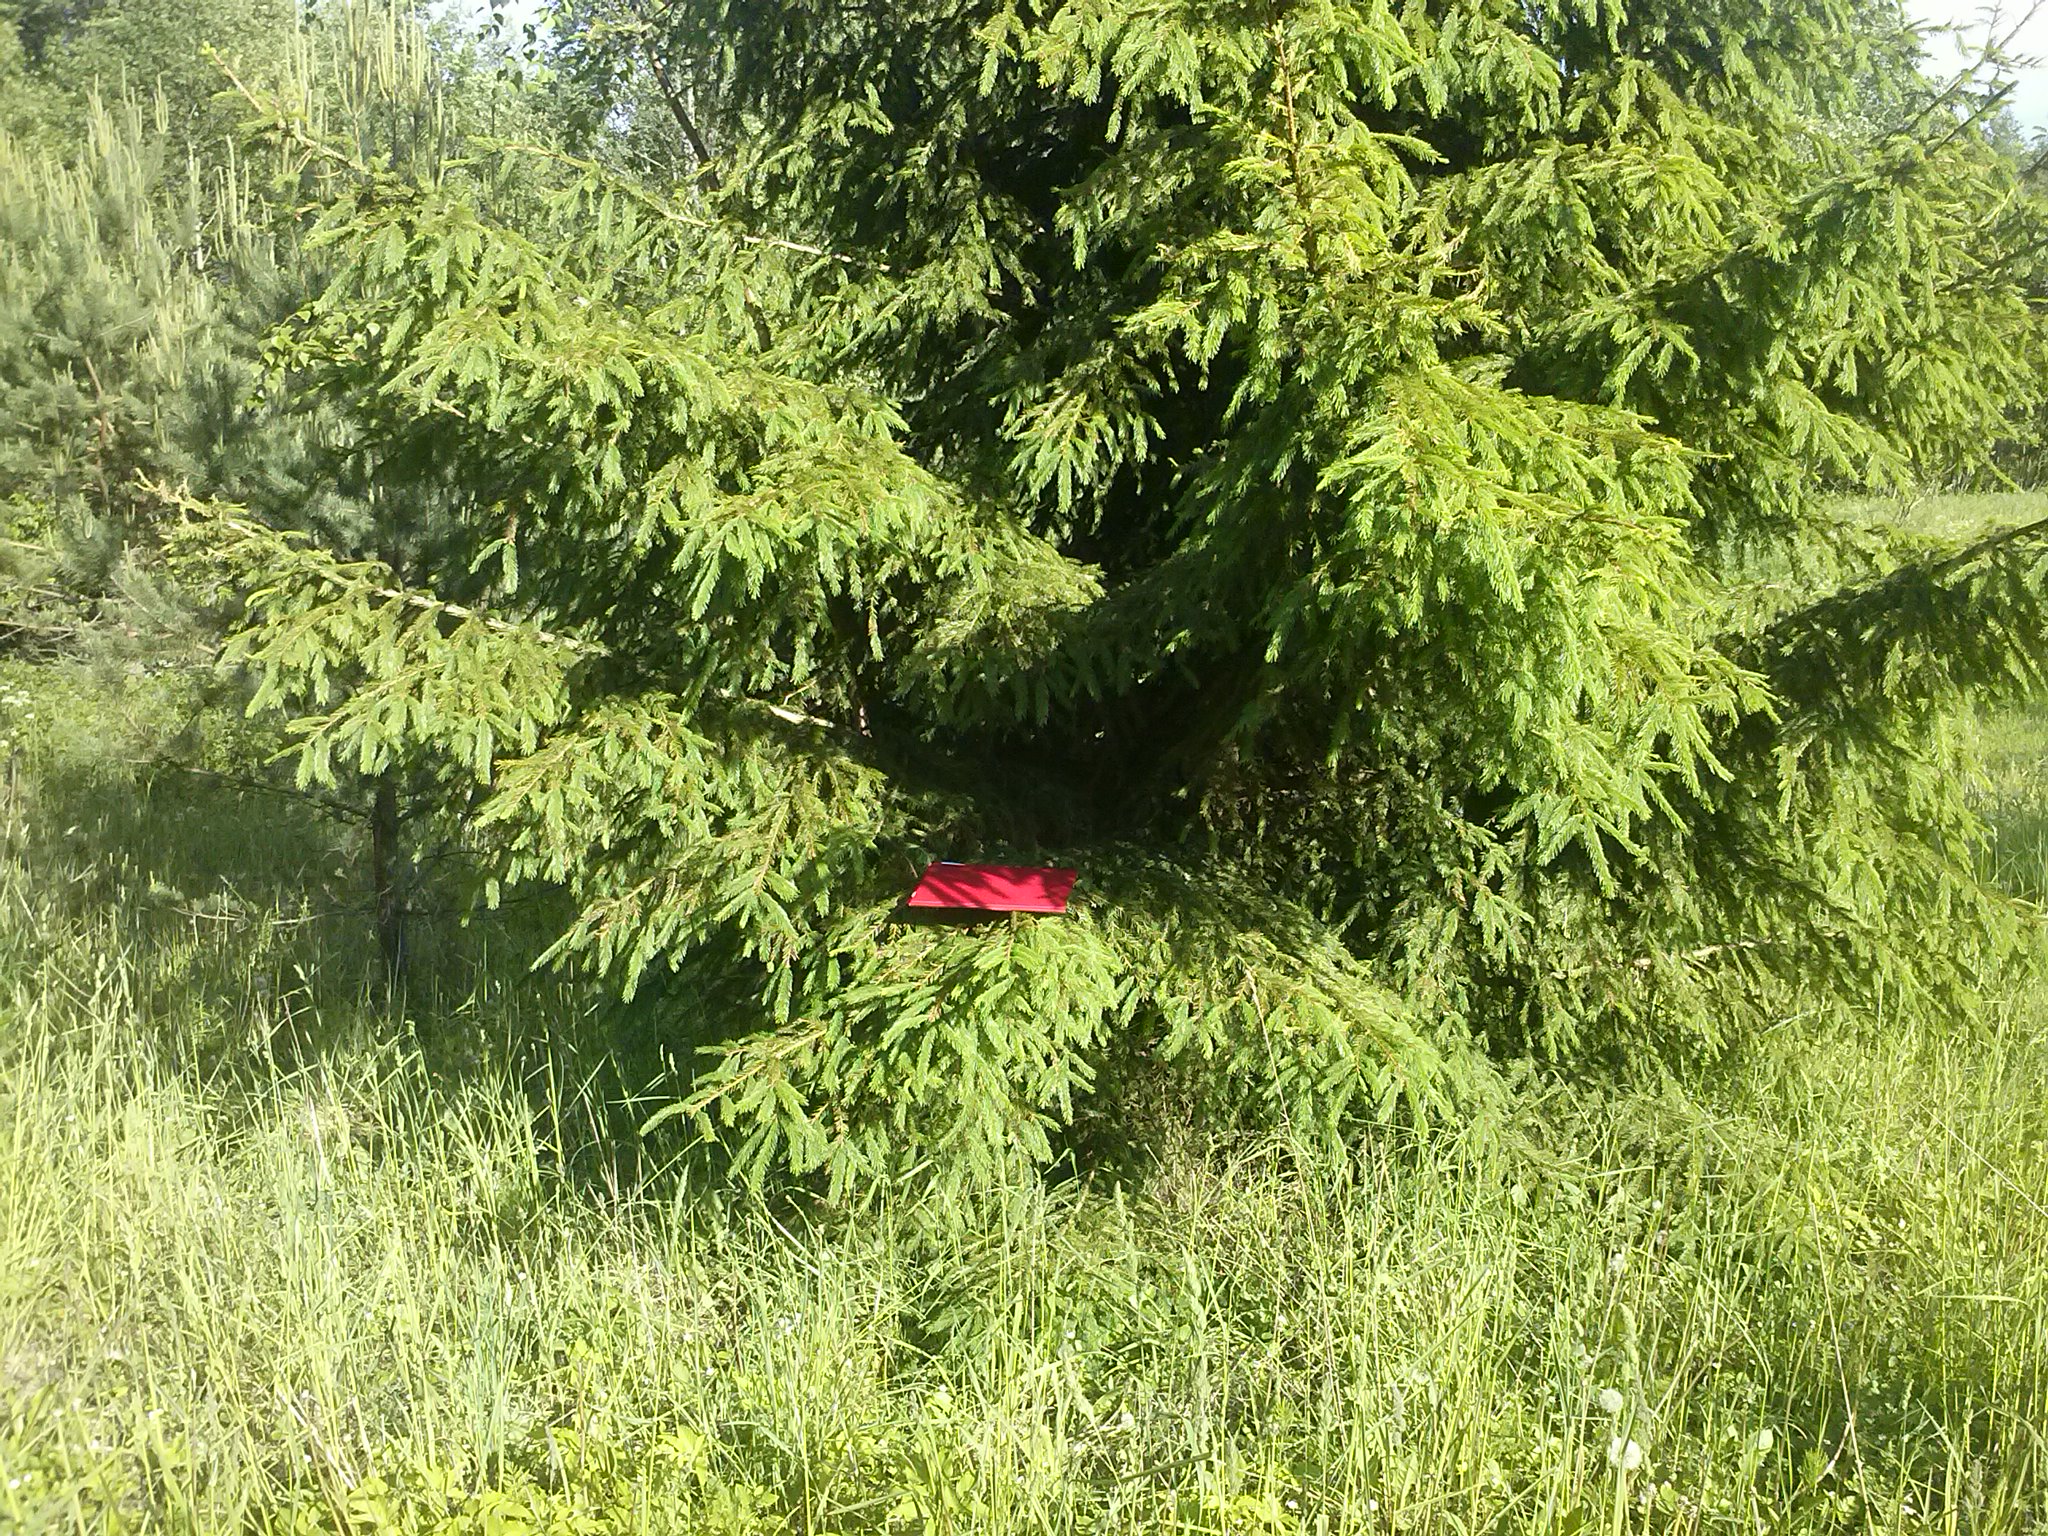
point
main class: Grassland
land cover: Grassland with sparse tree/shrub cover
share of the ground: > 75 %
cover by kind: herbaceous plants 90 %, coniferous forest trees 5 %, shrubs 5 %
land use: Forestry
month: June
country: LV
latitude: 56.3530
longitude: 27.6461
